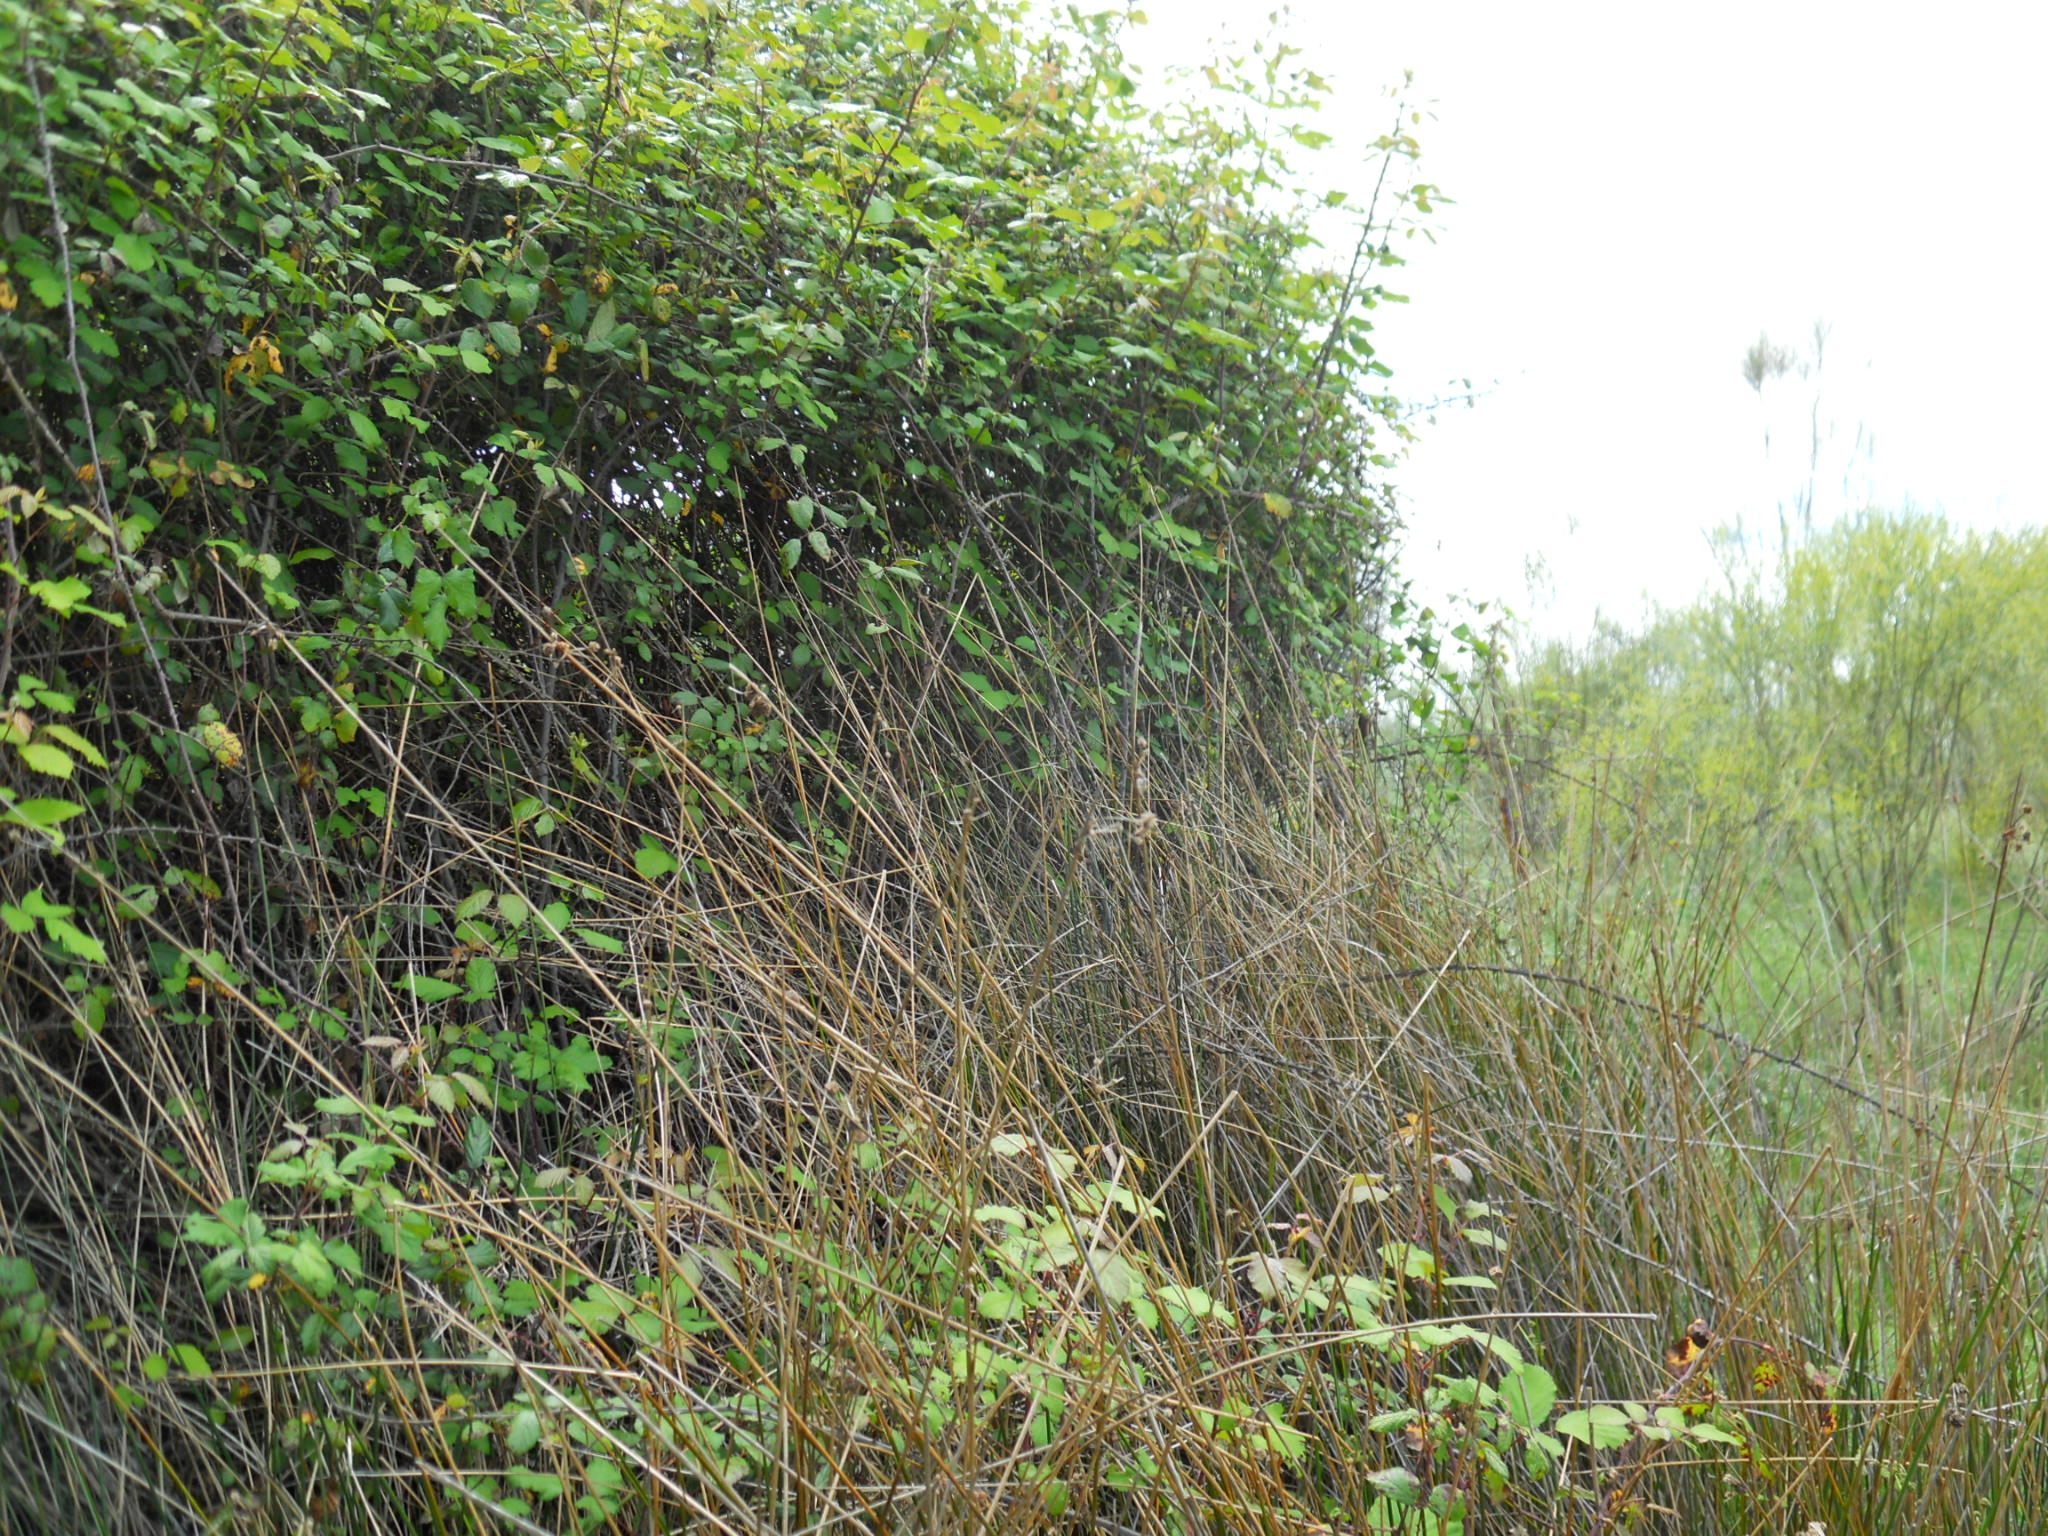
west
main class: Shrubland
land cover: Shrubland with sparse tree cover
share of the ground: > 75 %
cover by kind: shrubs 80 %, herbaceous plants 15 %, broadleaved forest trees 5 %
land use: Agriculture (excluding fallow land and kitchen gardens)
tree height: > 5 m
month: May
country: ES
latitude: 39.1616
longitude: -6.9835
